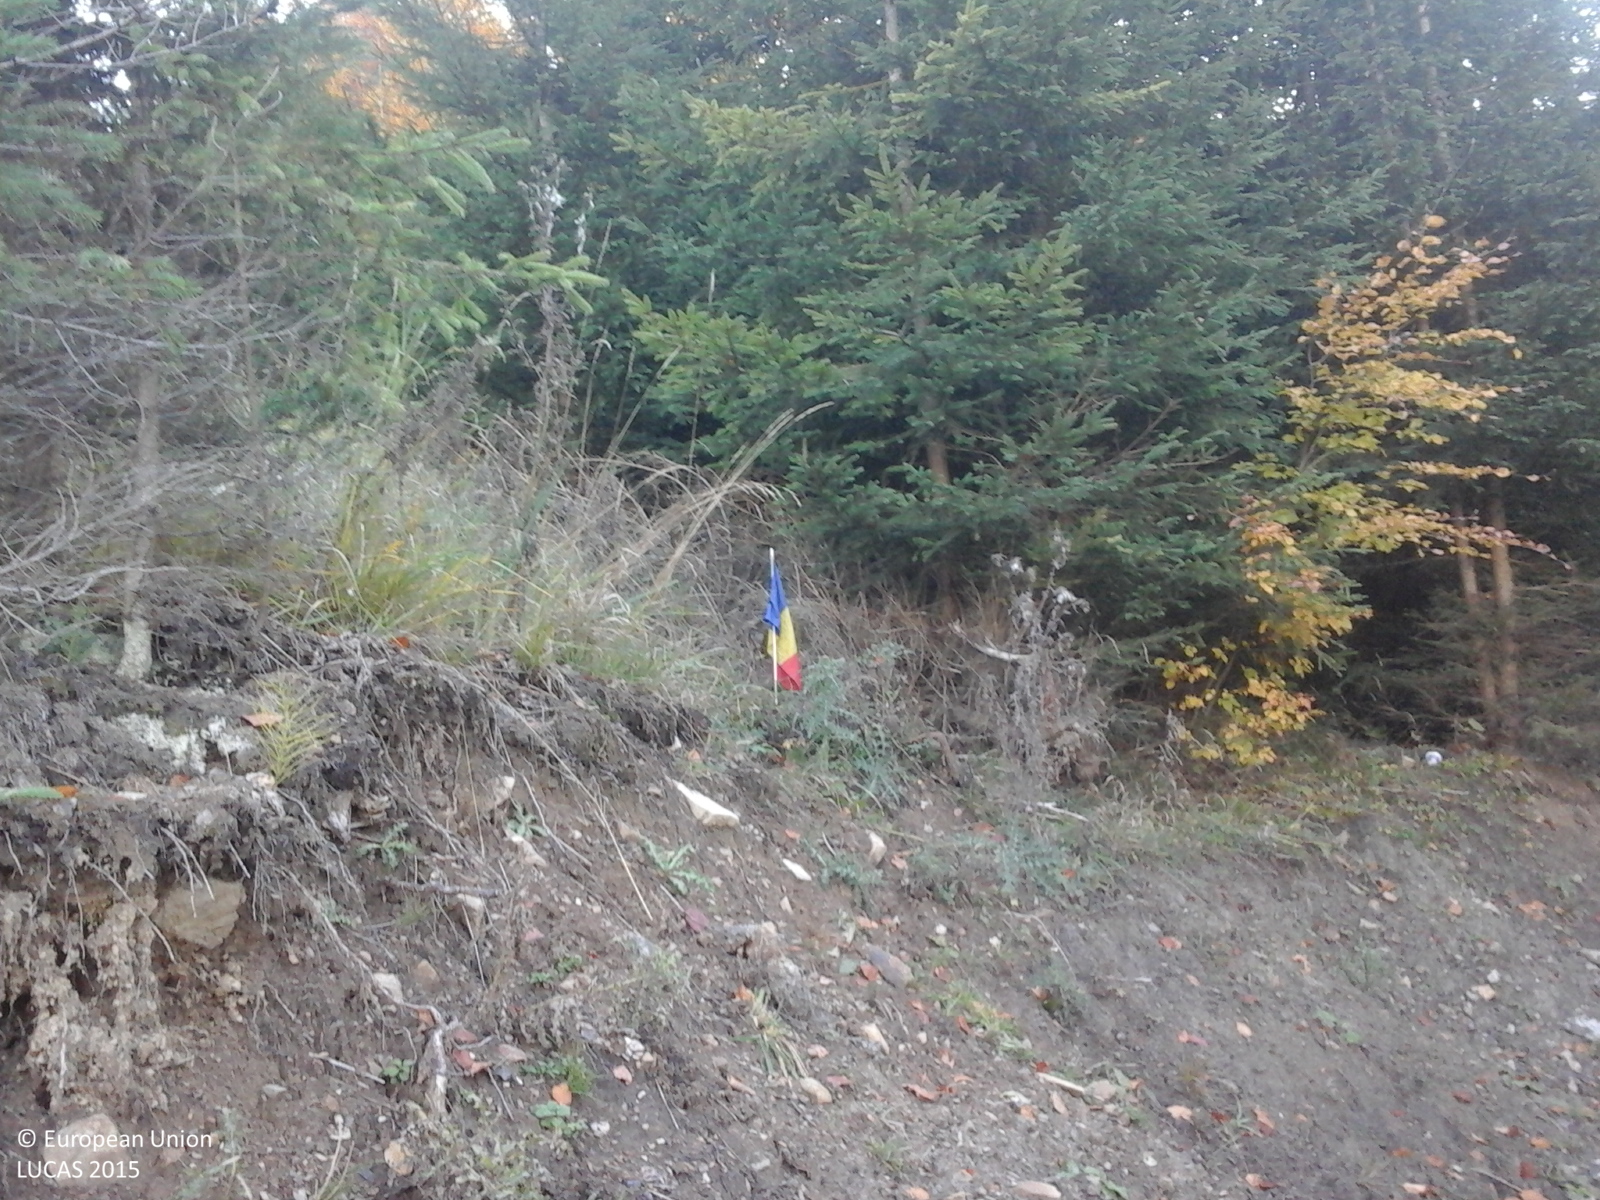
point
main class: Woodland
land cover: Spruce dominated coniferous woodland
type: alpine coniferous forest
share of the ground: > 75 %
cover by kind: coniferous forest trees 75 %, broadleaved forest trees 25 %
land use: Forestry
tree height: > 5 m
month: October
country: RO
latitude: 45.9660
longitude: 26.4526
